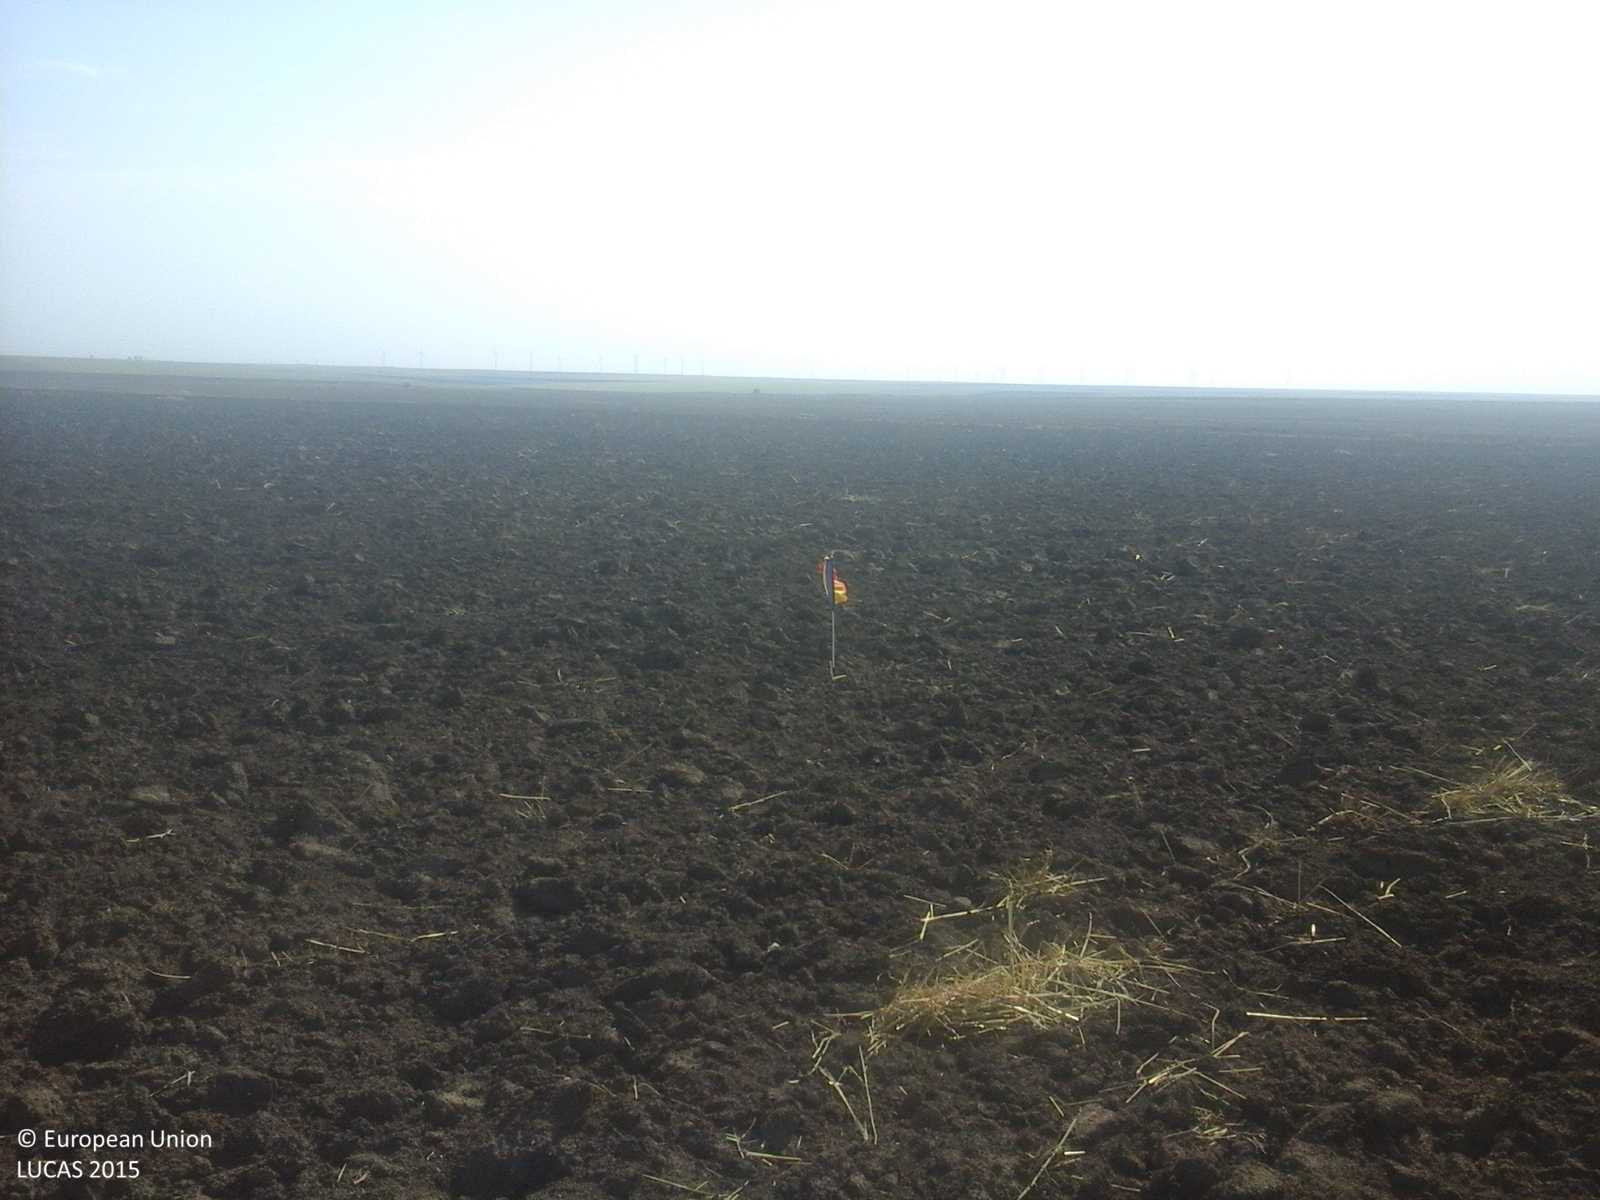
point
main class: Cropland
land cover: Common wheat
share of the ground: < 10 %
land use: Agriculture (excluding fallow land and kitchen gardens)
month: August
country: RO
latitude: 43.9536
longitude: 28.2398
